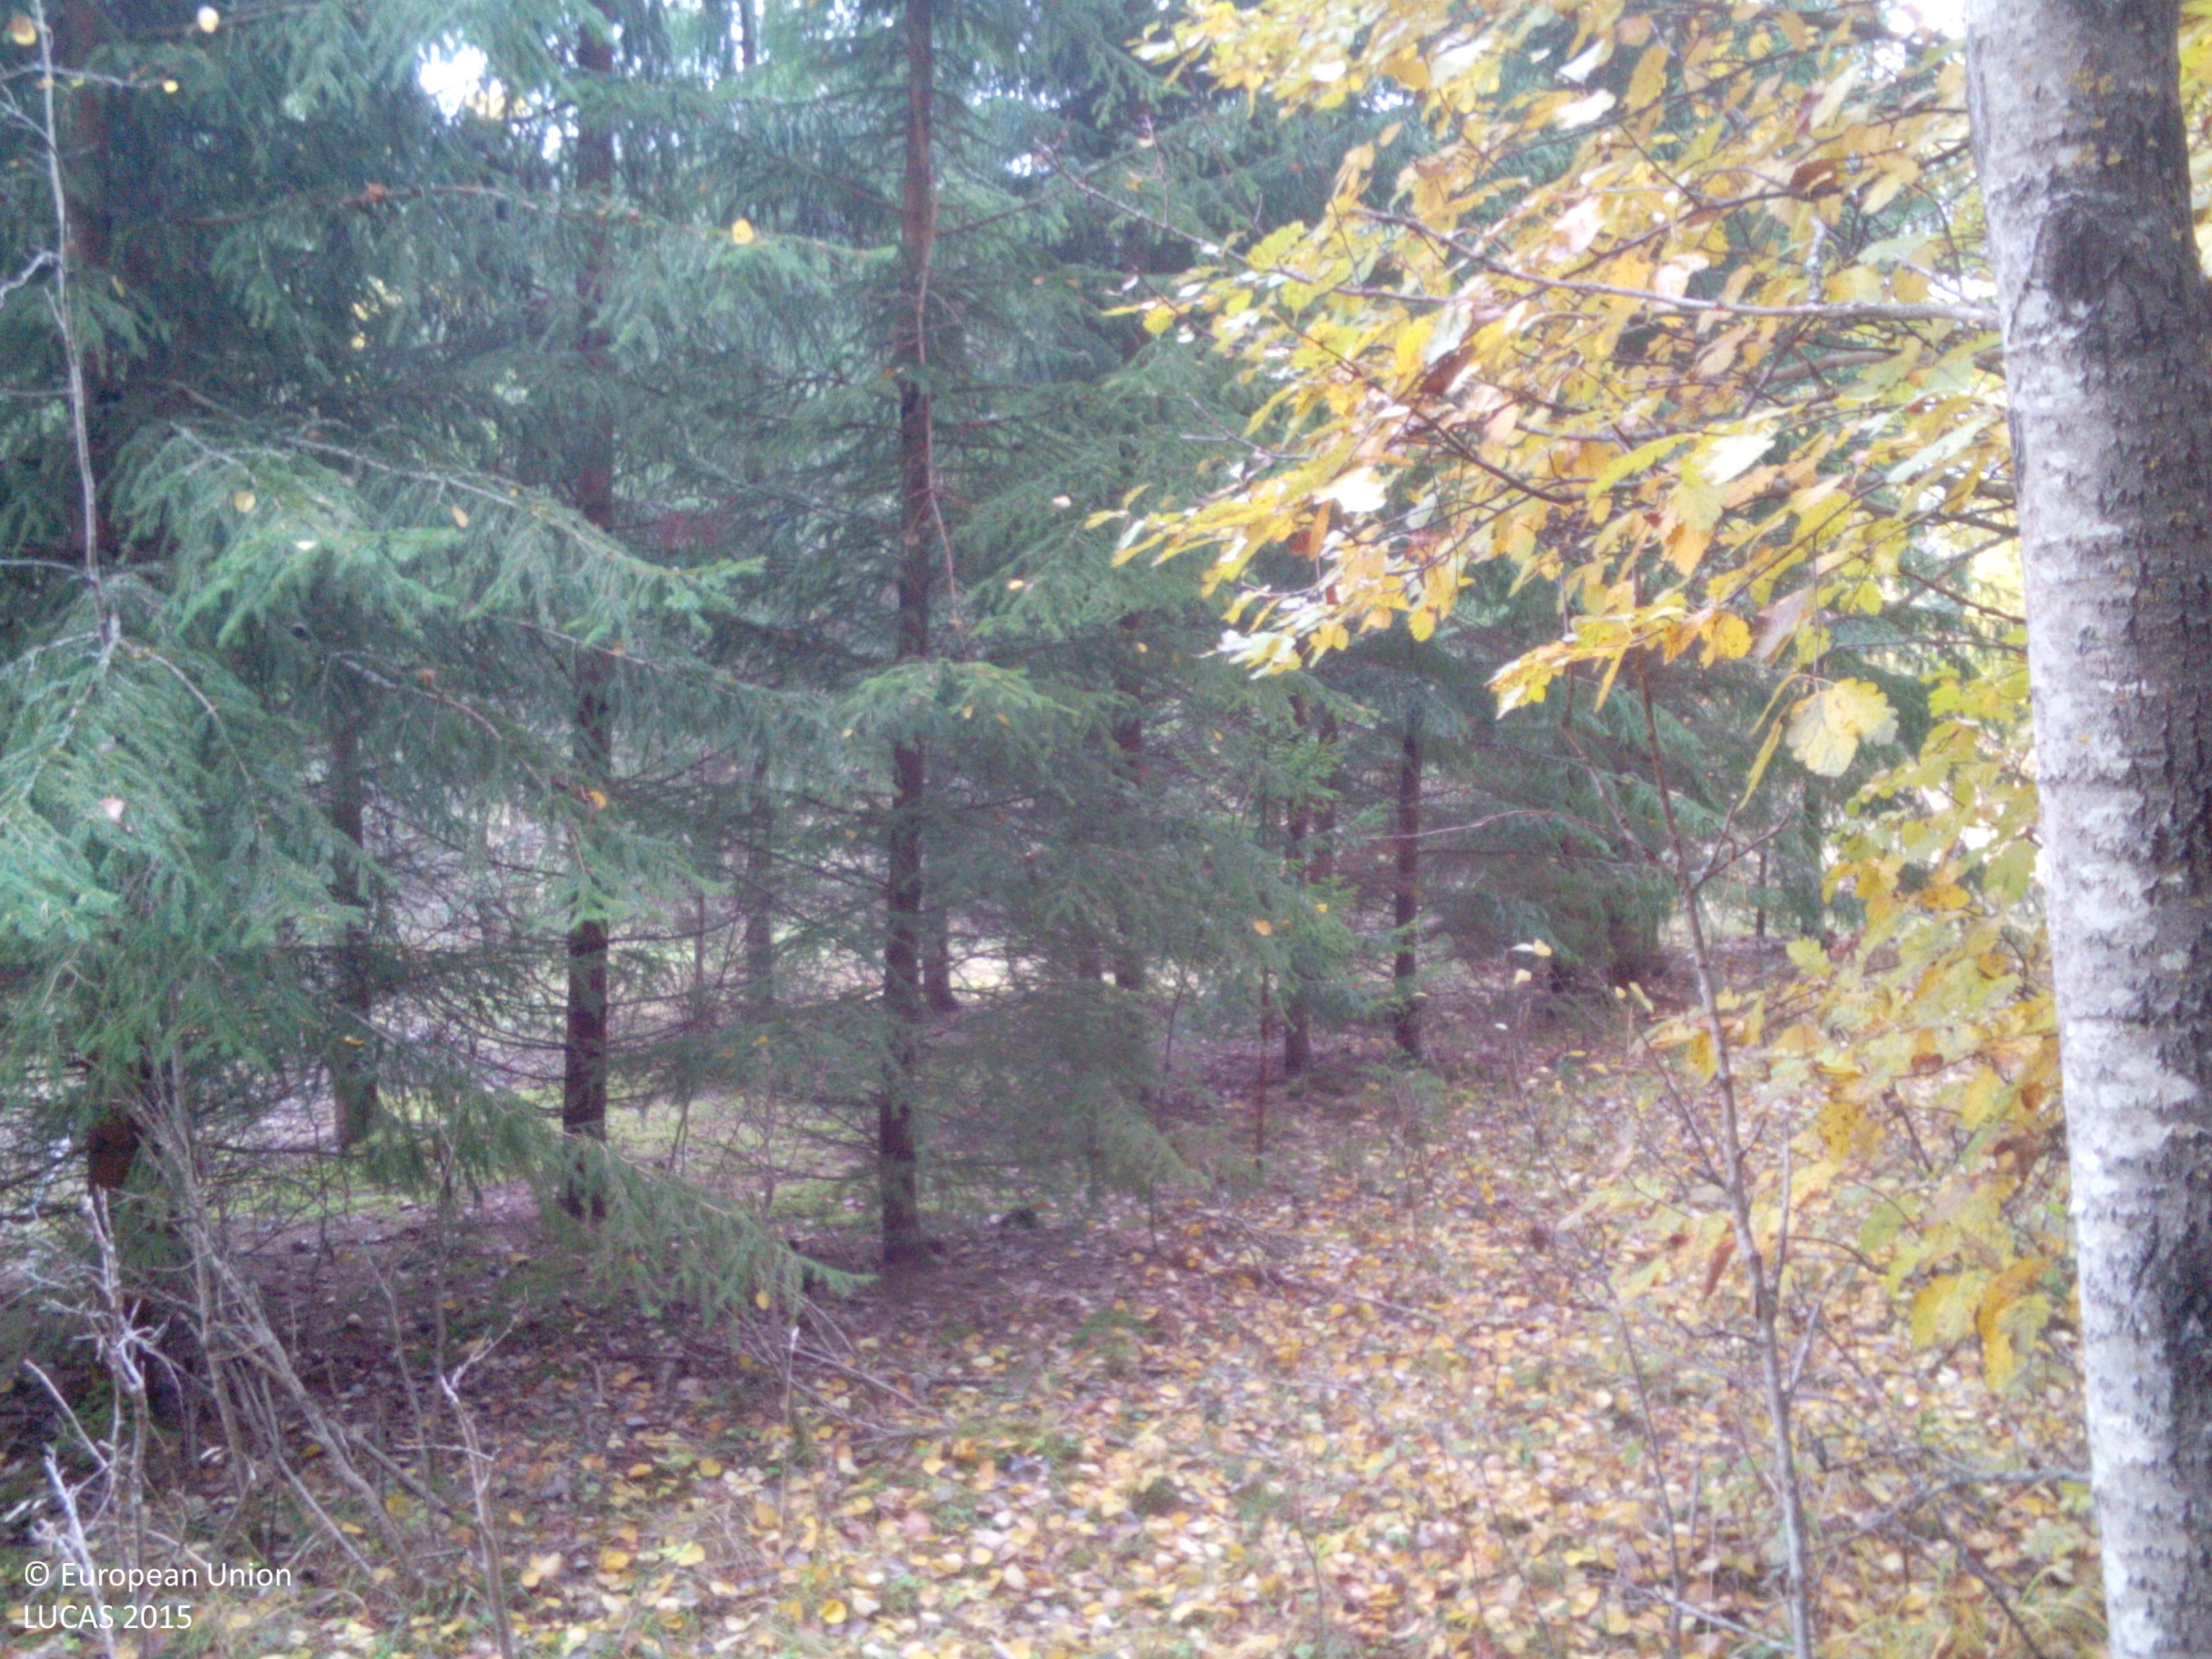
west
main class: Woodland
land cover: Other mixed woodland
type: boreal forest
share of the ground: > 75 %
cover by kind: coniferous forest trees 60 %, broadleaved forest trees 25 %, lichens and mosses 10 %, herbaceous plants 5 %
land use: Forestry
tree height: > 5 m
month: October
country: SE
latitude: 59.2100
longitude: 16.2808
